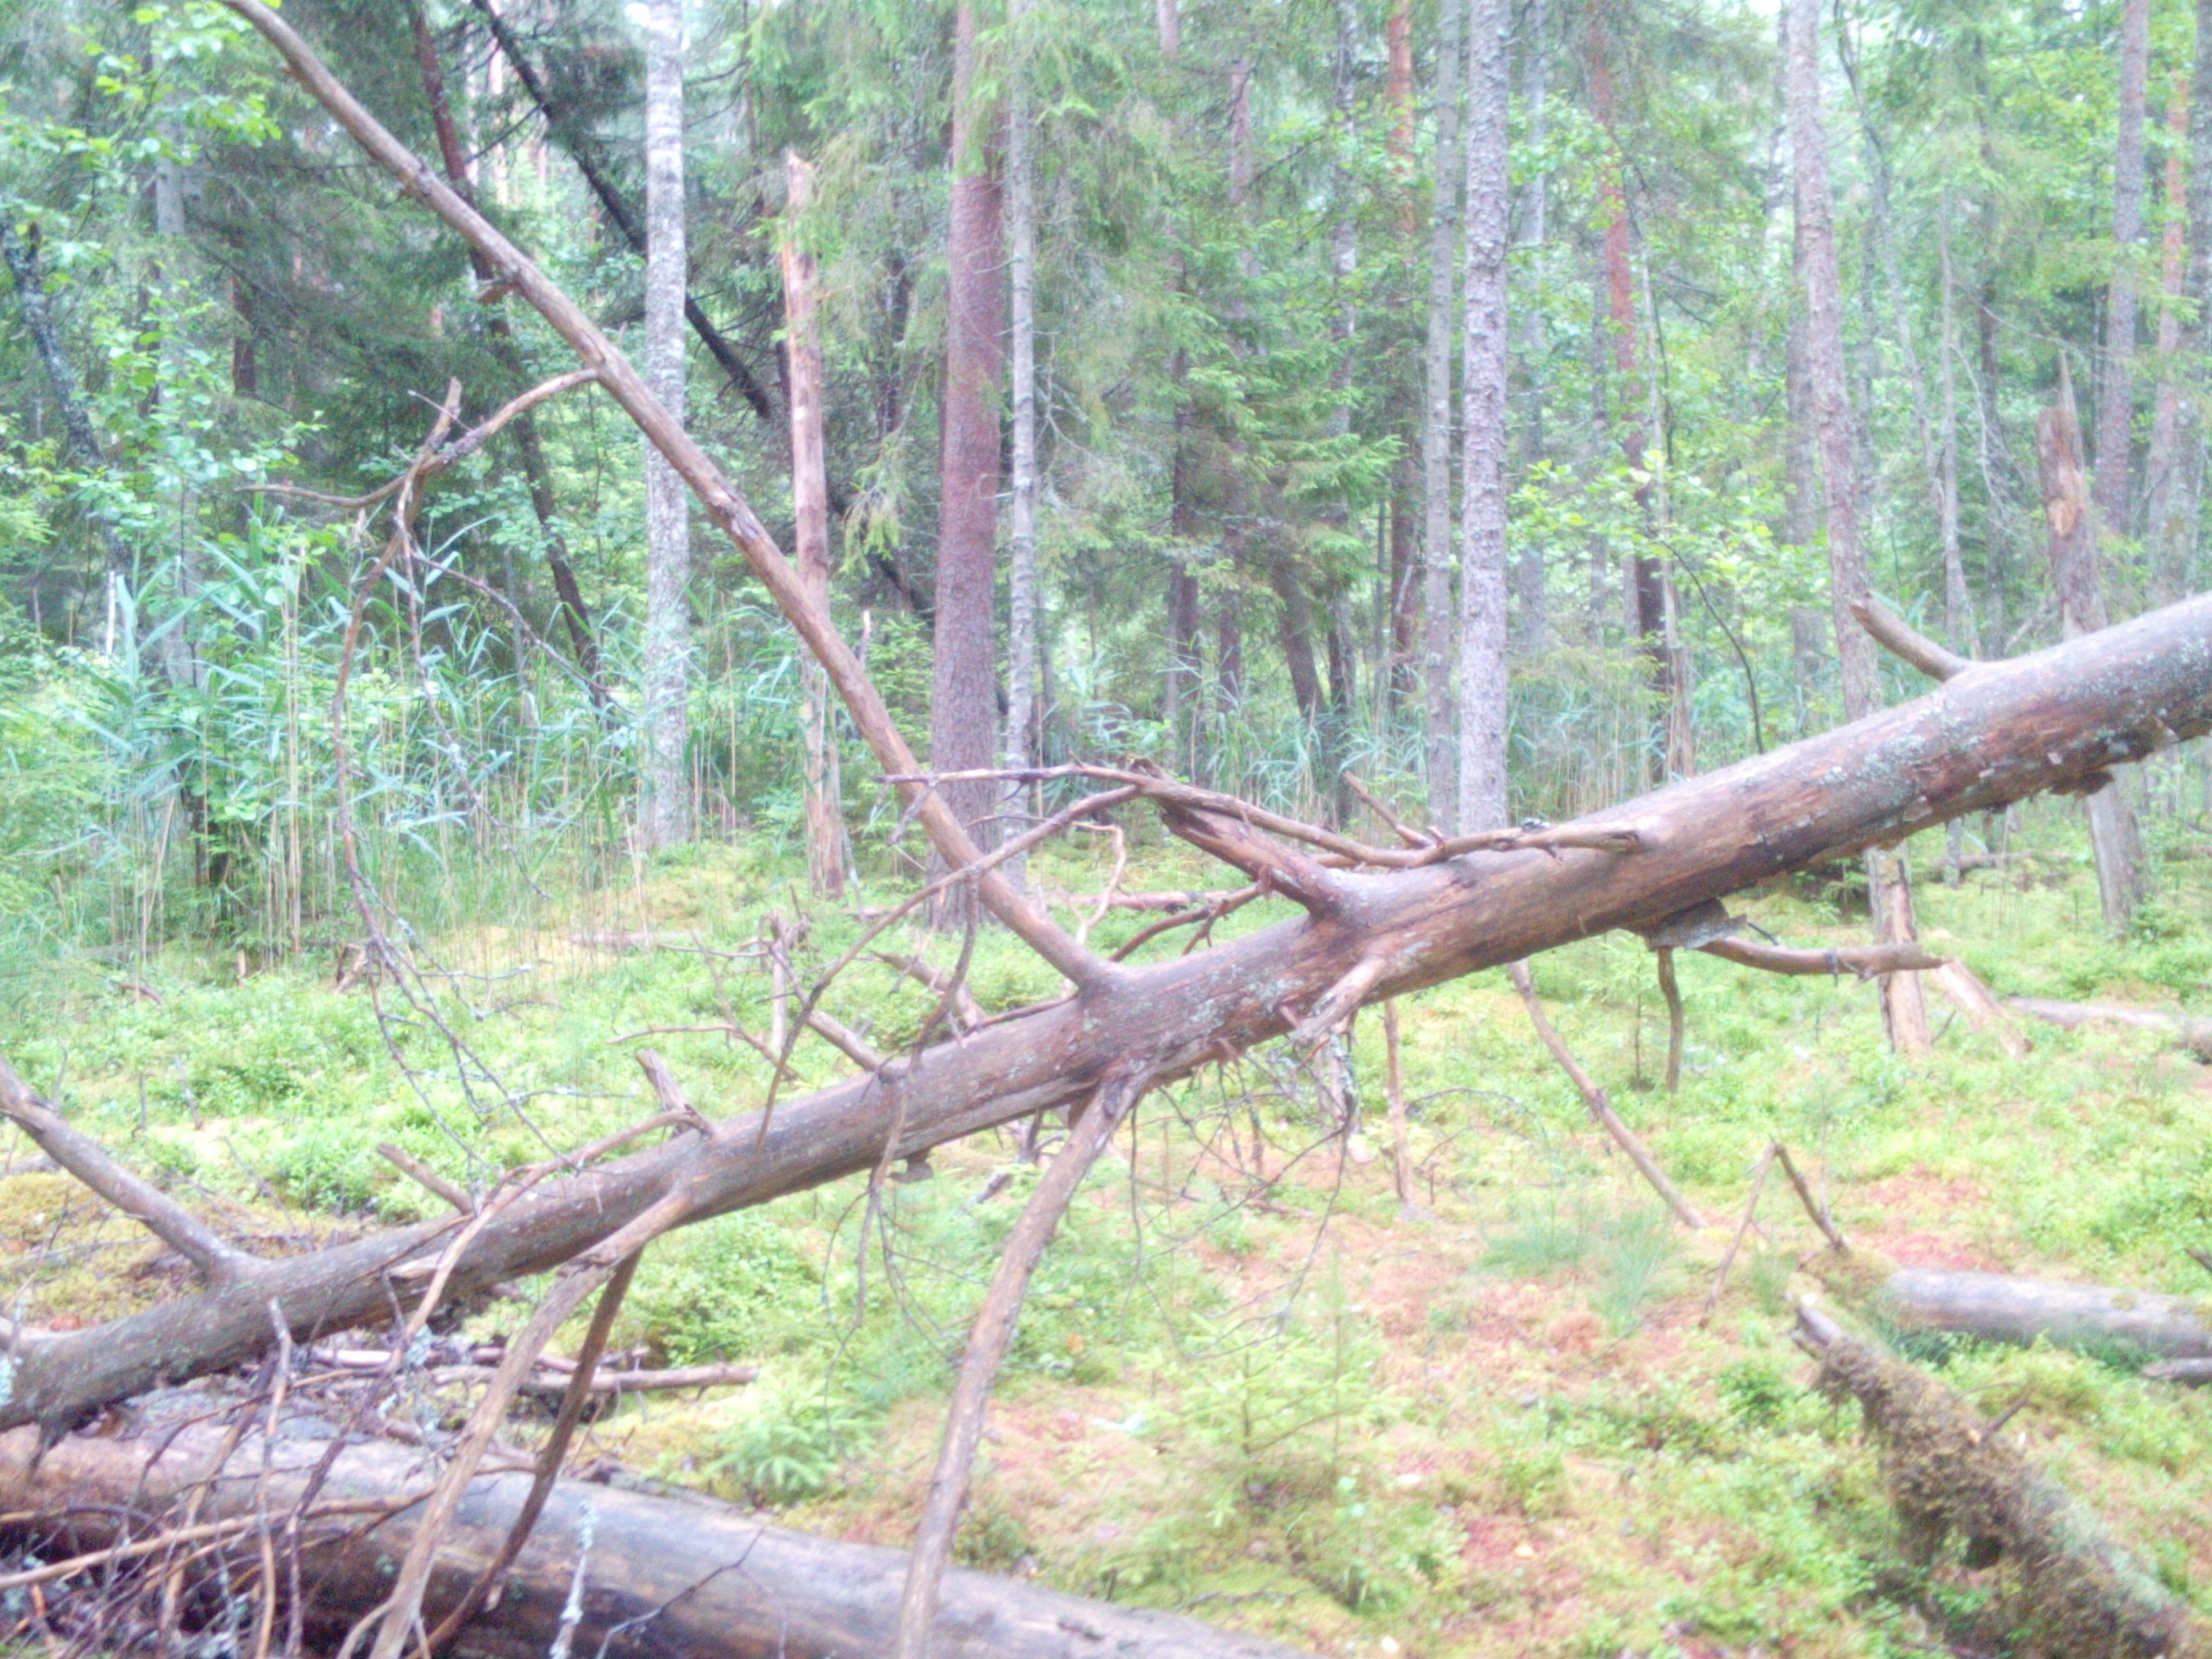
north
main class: Woodland
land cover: Other coniferous woodland
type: hemiboreal forest and nemoral coniferous forest and mixed broadleaved-coniferous forest
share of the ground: > 75 %
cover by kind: coniferous forest trees 75 %, broadleaved forest trees 10 %, lichens and mosses 10 %, herbaceous plants 5 %
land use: Forestry
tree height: > 5 m
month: July
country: LV
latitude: 57.0187
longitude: 22.0554
